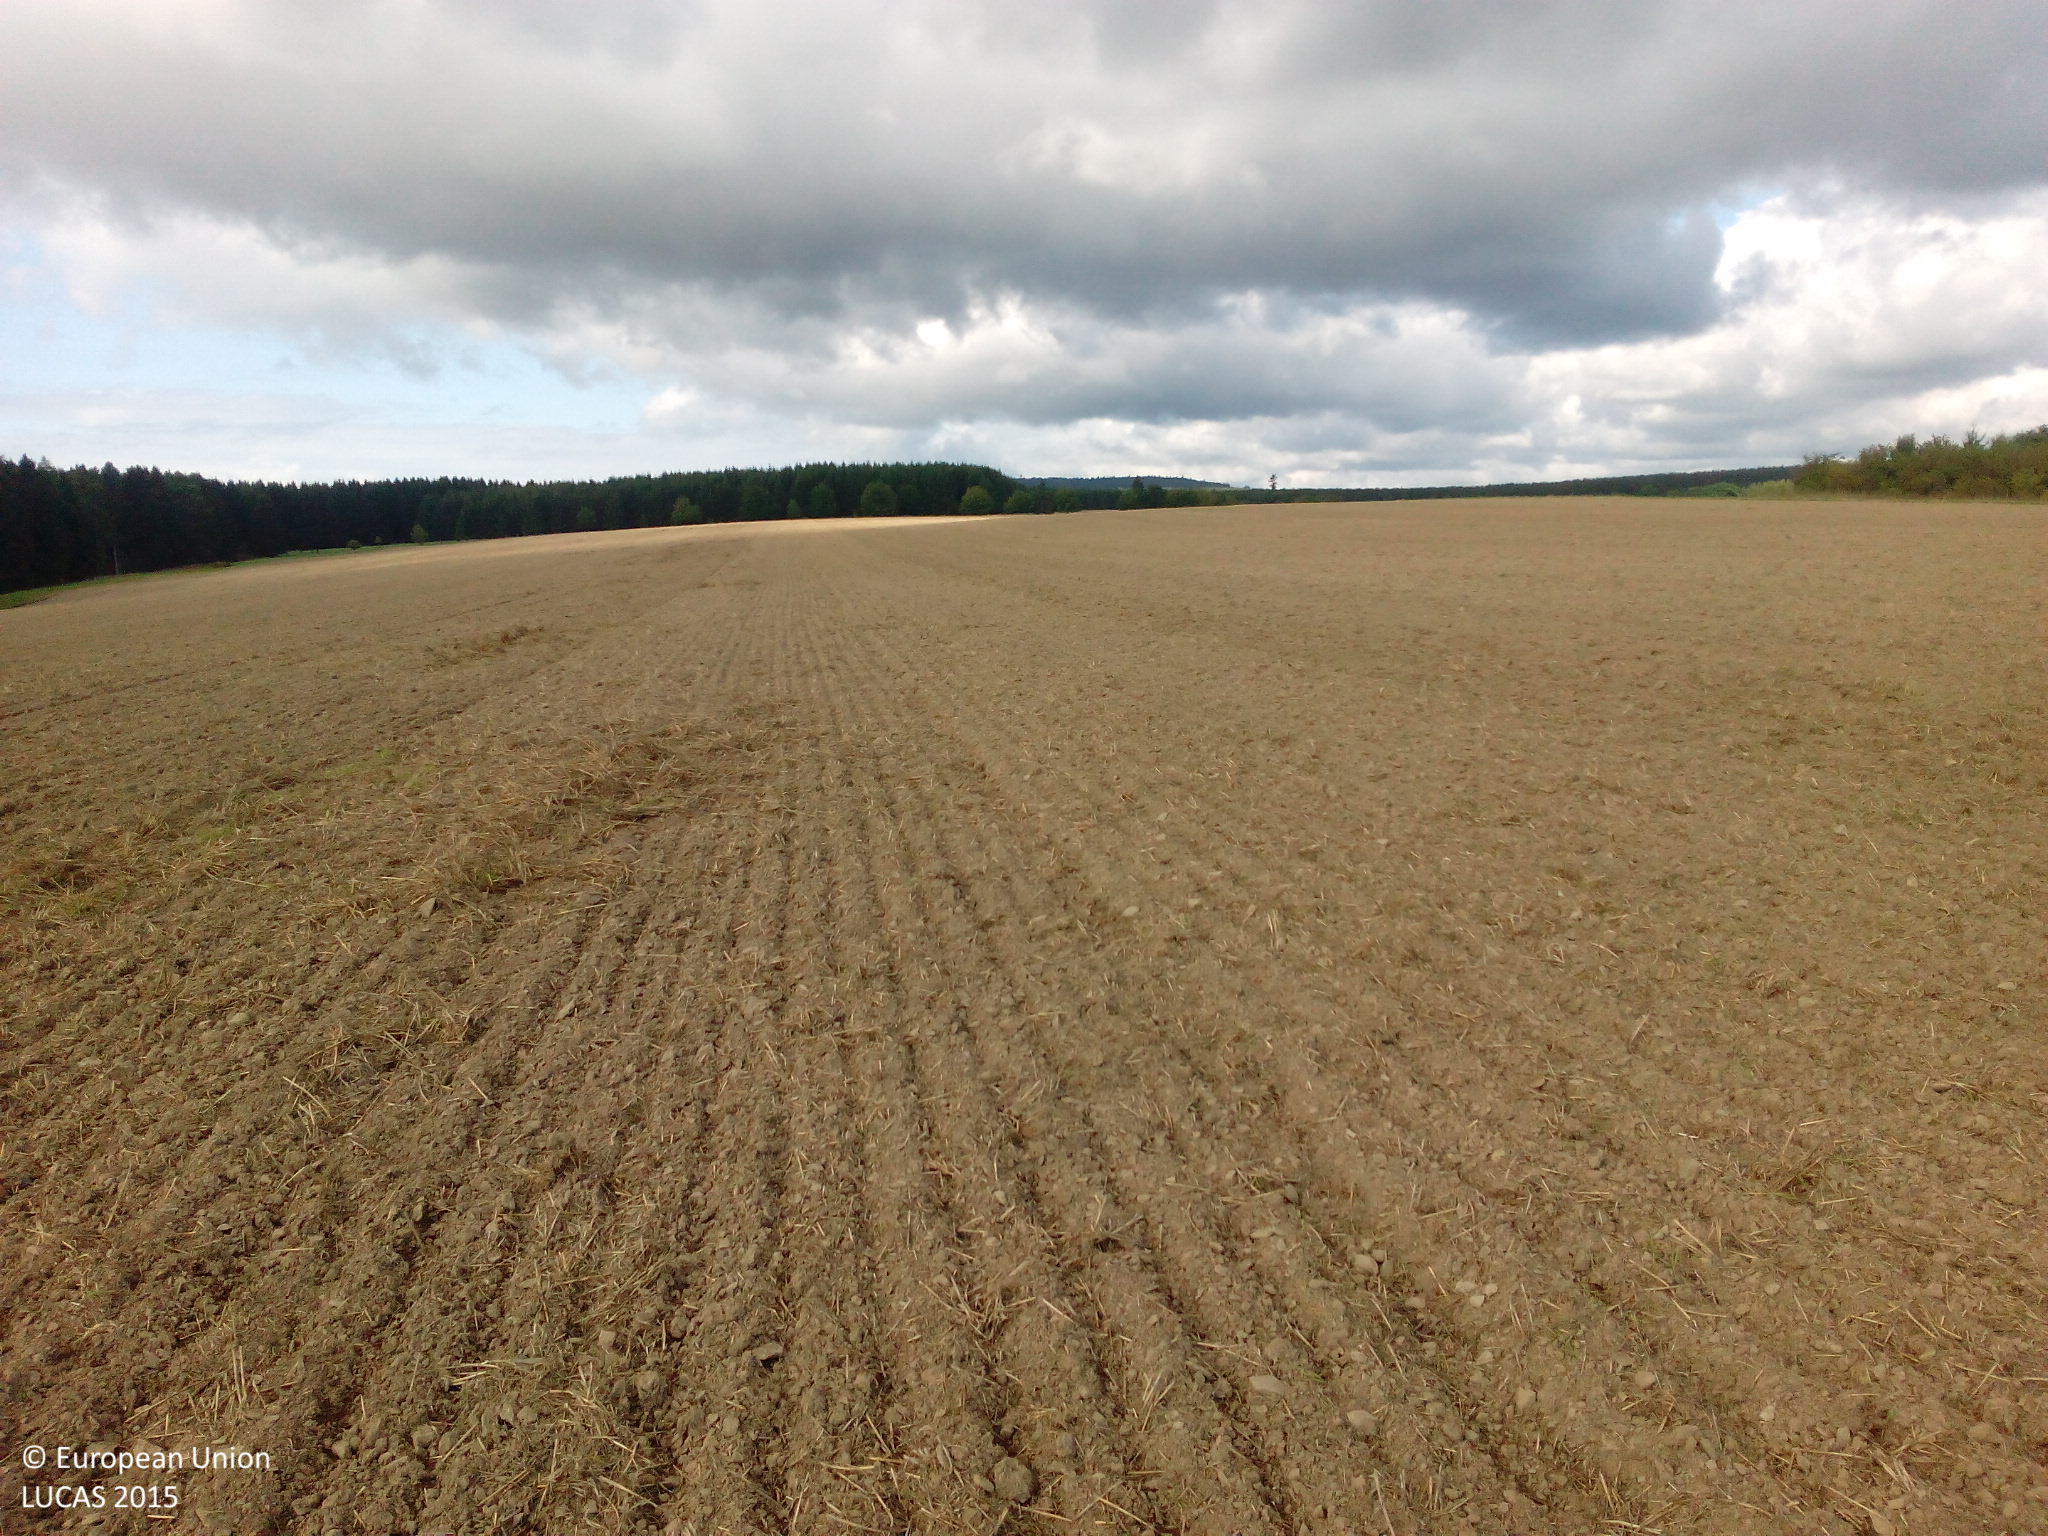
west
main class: Cropland
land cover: Common wheat
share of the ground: < 10 %
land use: Agriculture (excluding fallow land and kitchen gardens)
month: September
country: DE
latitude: 51.5816
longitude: 11.0820
